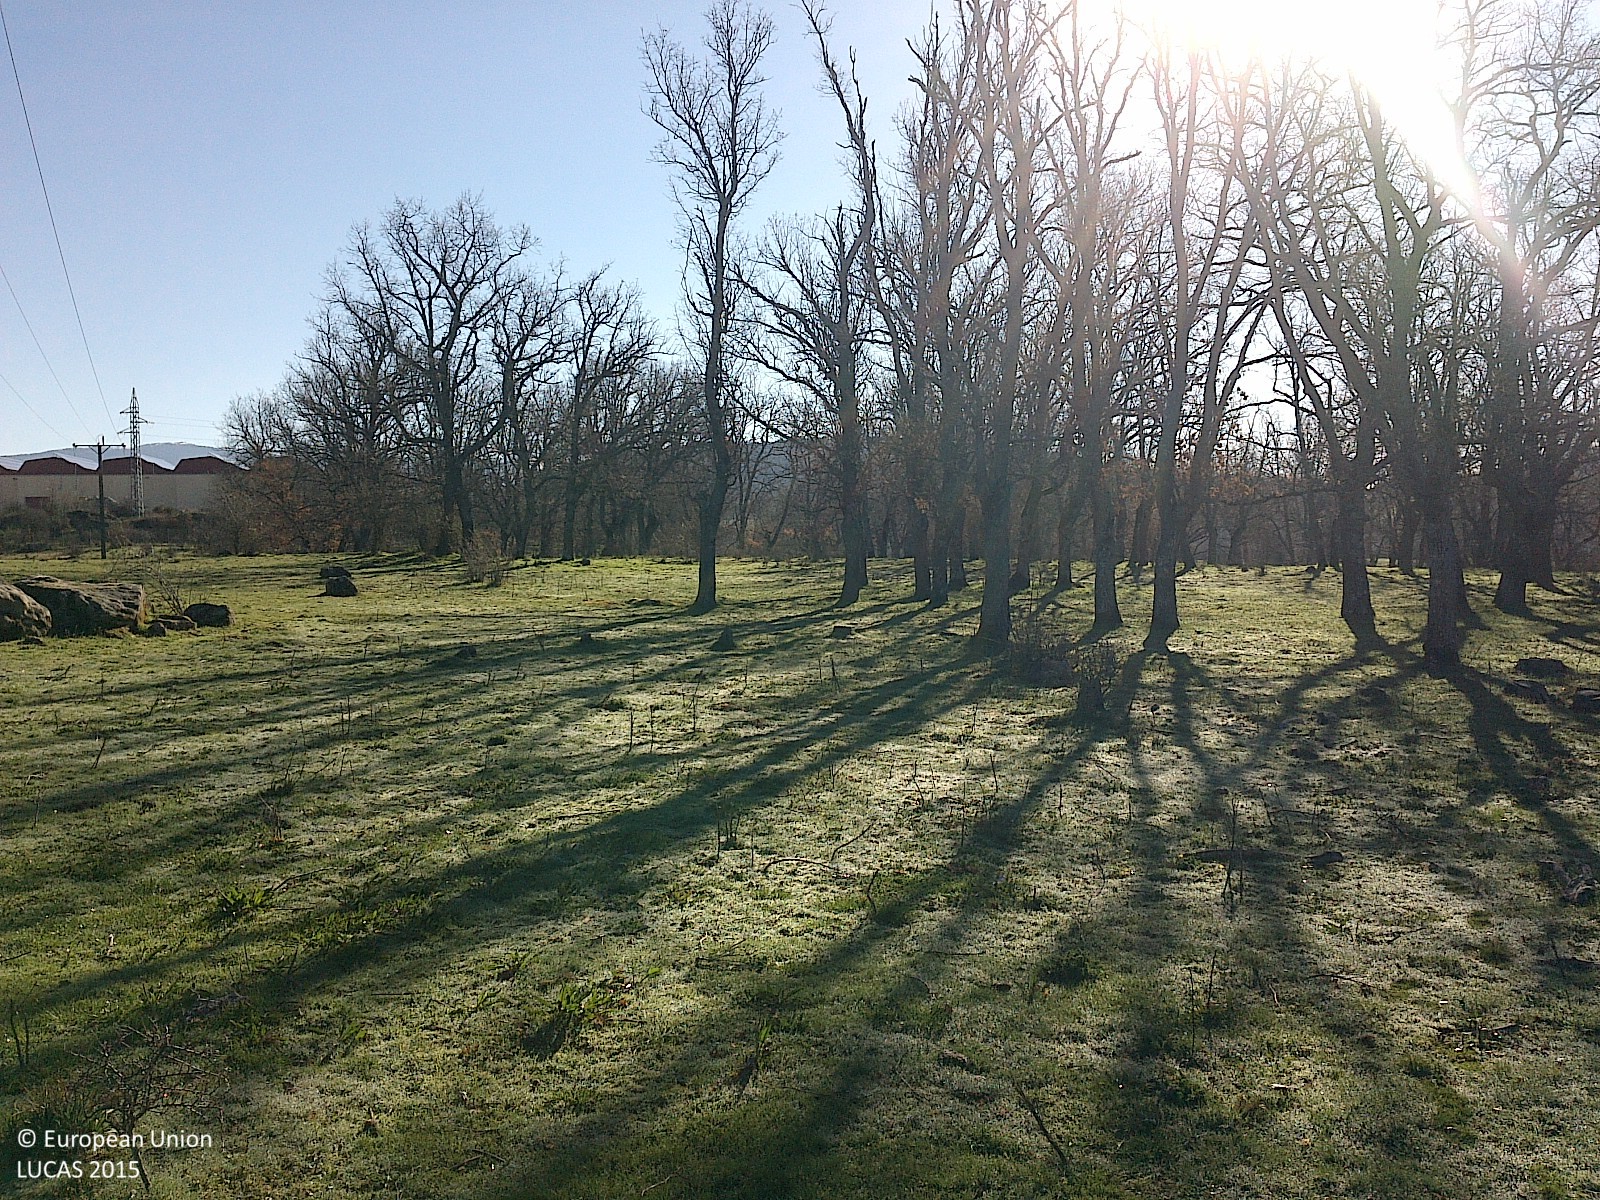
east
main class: Woodland
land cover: Broadleaved woodland
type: thermophilous deciduous forest
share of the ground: 10 - 25 %
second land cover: Spontaneously vegetated surfaces
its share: > 75 %
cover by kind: herbaceous plants 80 %, broadleaved forest trees 10 %, shrubs 10 %
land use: Forestry
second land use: Agriculture (excluding fallow land and kitchen gardens)
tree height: > 5 m
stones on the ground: < 10 %
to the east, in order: Broadleaved woodland; Spontaneously vegetated surfaces; Rivers and streams; Broadleaved woodland; Spontaneously vegetated surfaces
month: April
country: ES
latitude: 41.9648
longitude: -3.0913
